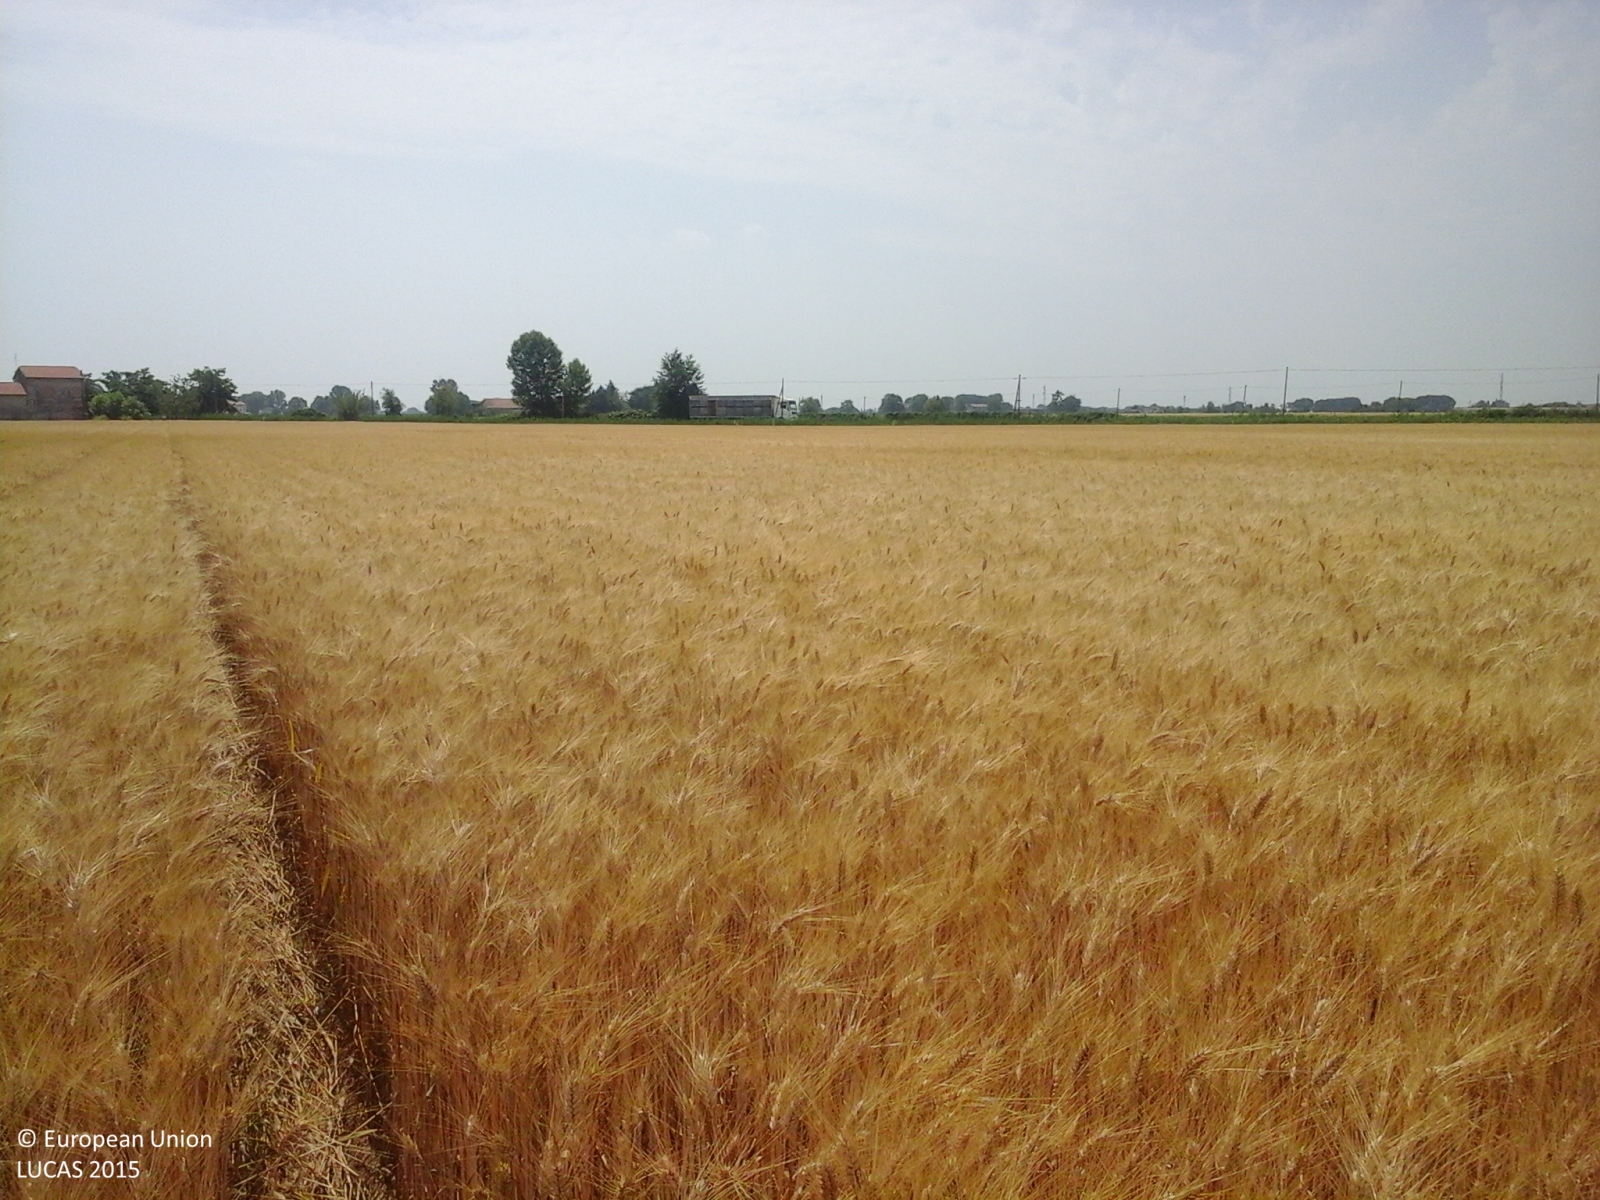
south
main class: Cropland
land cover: Durum wheat
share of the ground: > 75 %
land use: Agriculture (excluding fallow land and kitchen gardens)
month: June
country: IT
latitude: 45.2651
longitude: 11.0305
